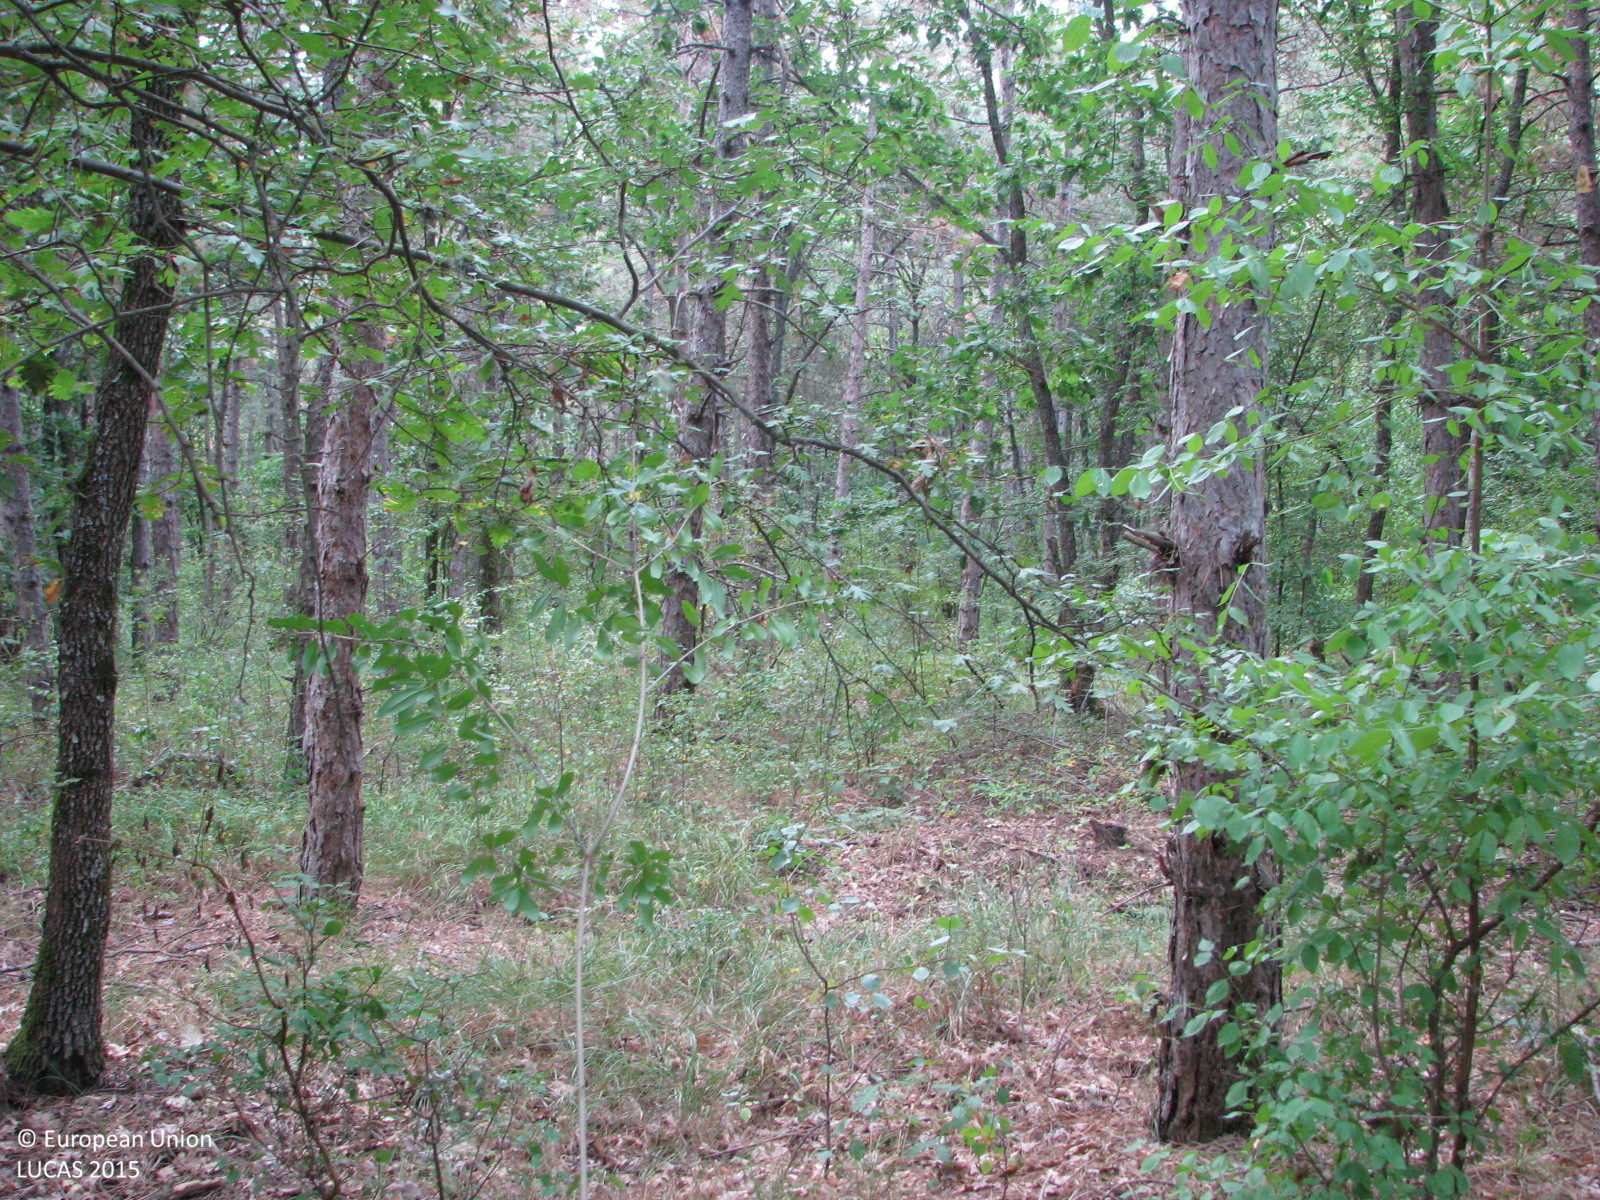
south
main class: Woodland
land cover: Pine dominated mixed woodland
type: hemiboreal forest and nemoral coniferous forest and mixed broadleaved-coniferous forest
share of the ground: > 75 %
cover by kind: coniferous forest trees 50 %, broadleaved forest trees 25 %, shrubs 15 %, herbaceous plants 10 %
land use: Forestry
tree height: > 5 m
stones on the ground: < 10 %
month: August
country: BG
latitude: 42.1051
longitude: 26.7942
